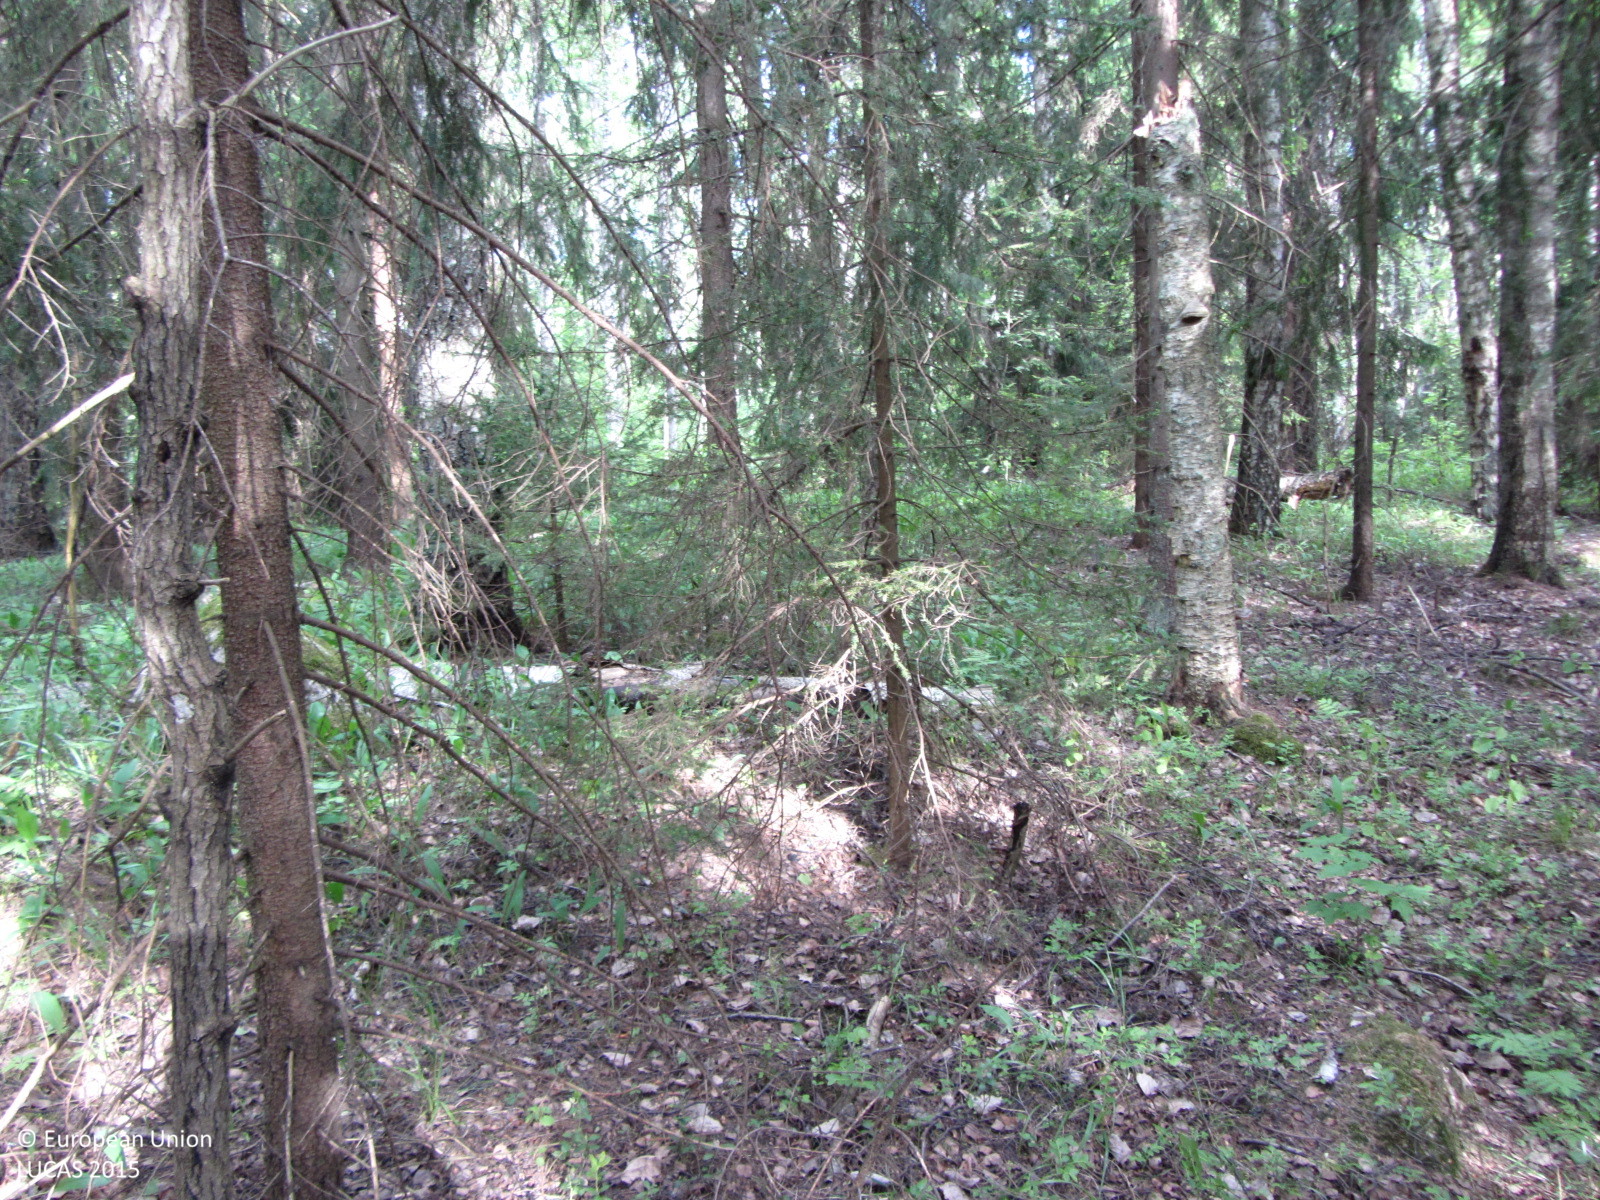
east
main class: Woodland
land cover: Spruce dominated mixed woodland
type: boreal forest
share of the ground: 50 - 75 %
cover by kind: coniferous forest trees 40 %, broadleaved forest trees 20 %, herbaceous plants 20 %, unconsolidated bare surface 20 %
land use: Residential
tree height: > 5 m
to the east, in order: Spruce dominated mixed woodland; Paved roads, cycling and walking lanes; Spruce dominated mixed woodland
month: June
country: FI
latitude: 60.3149
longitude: 24.2402
